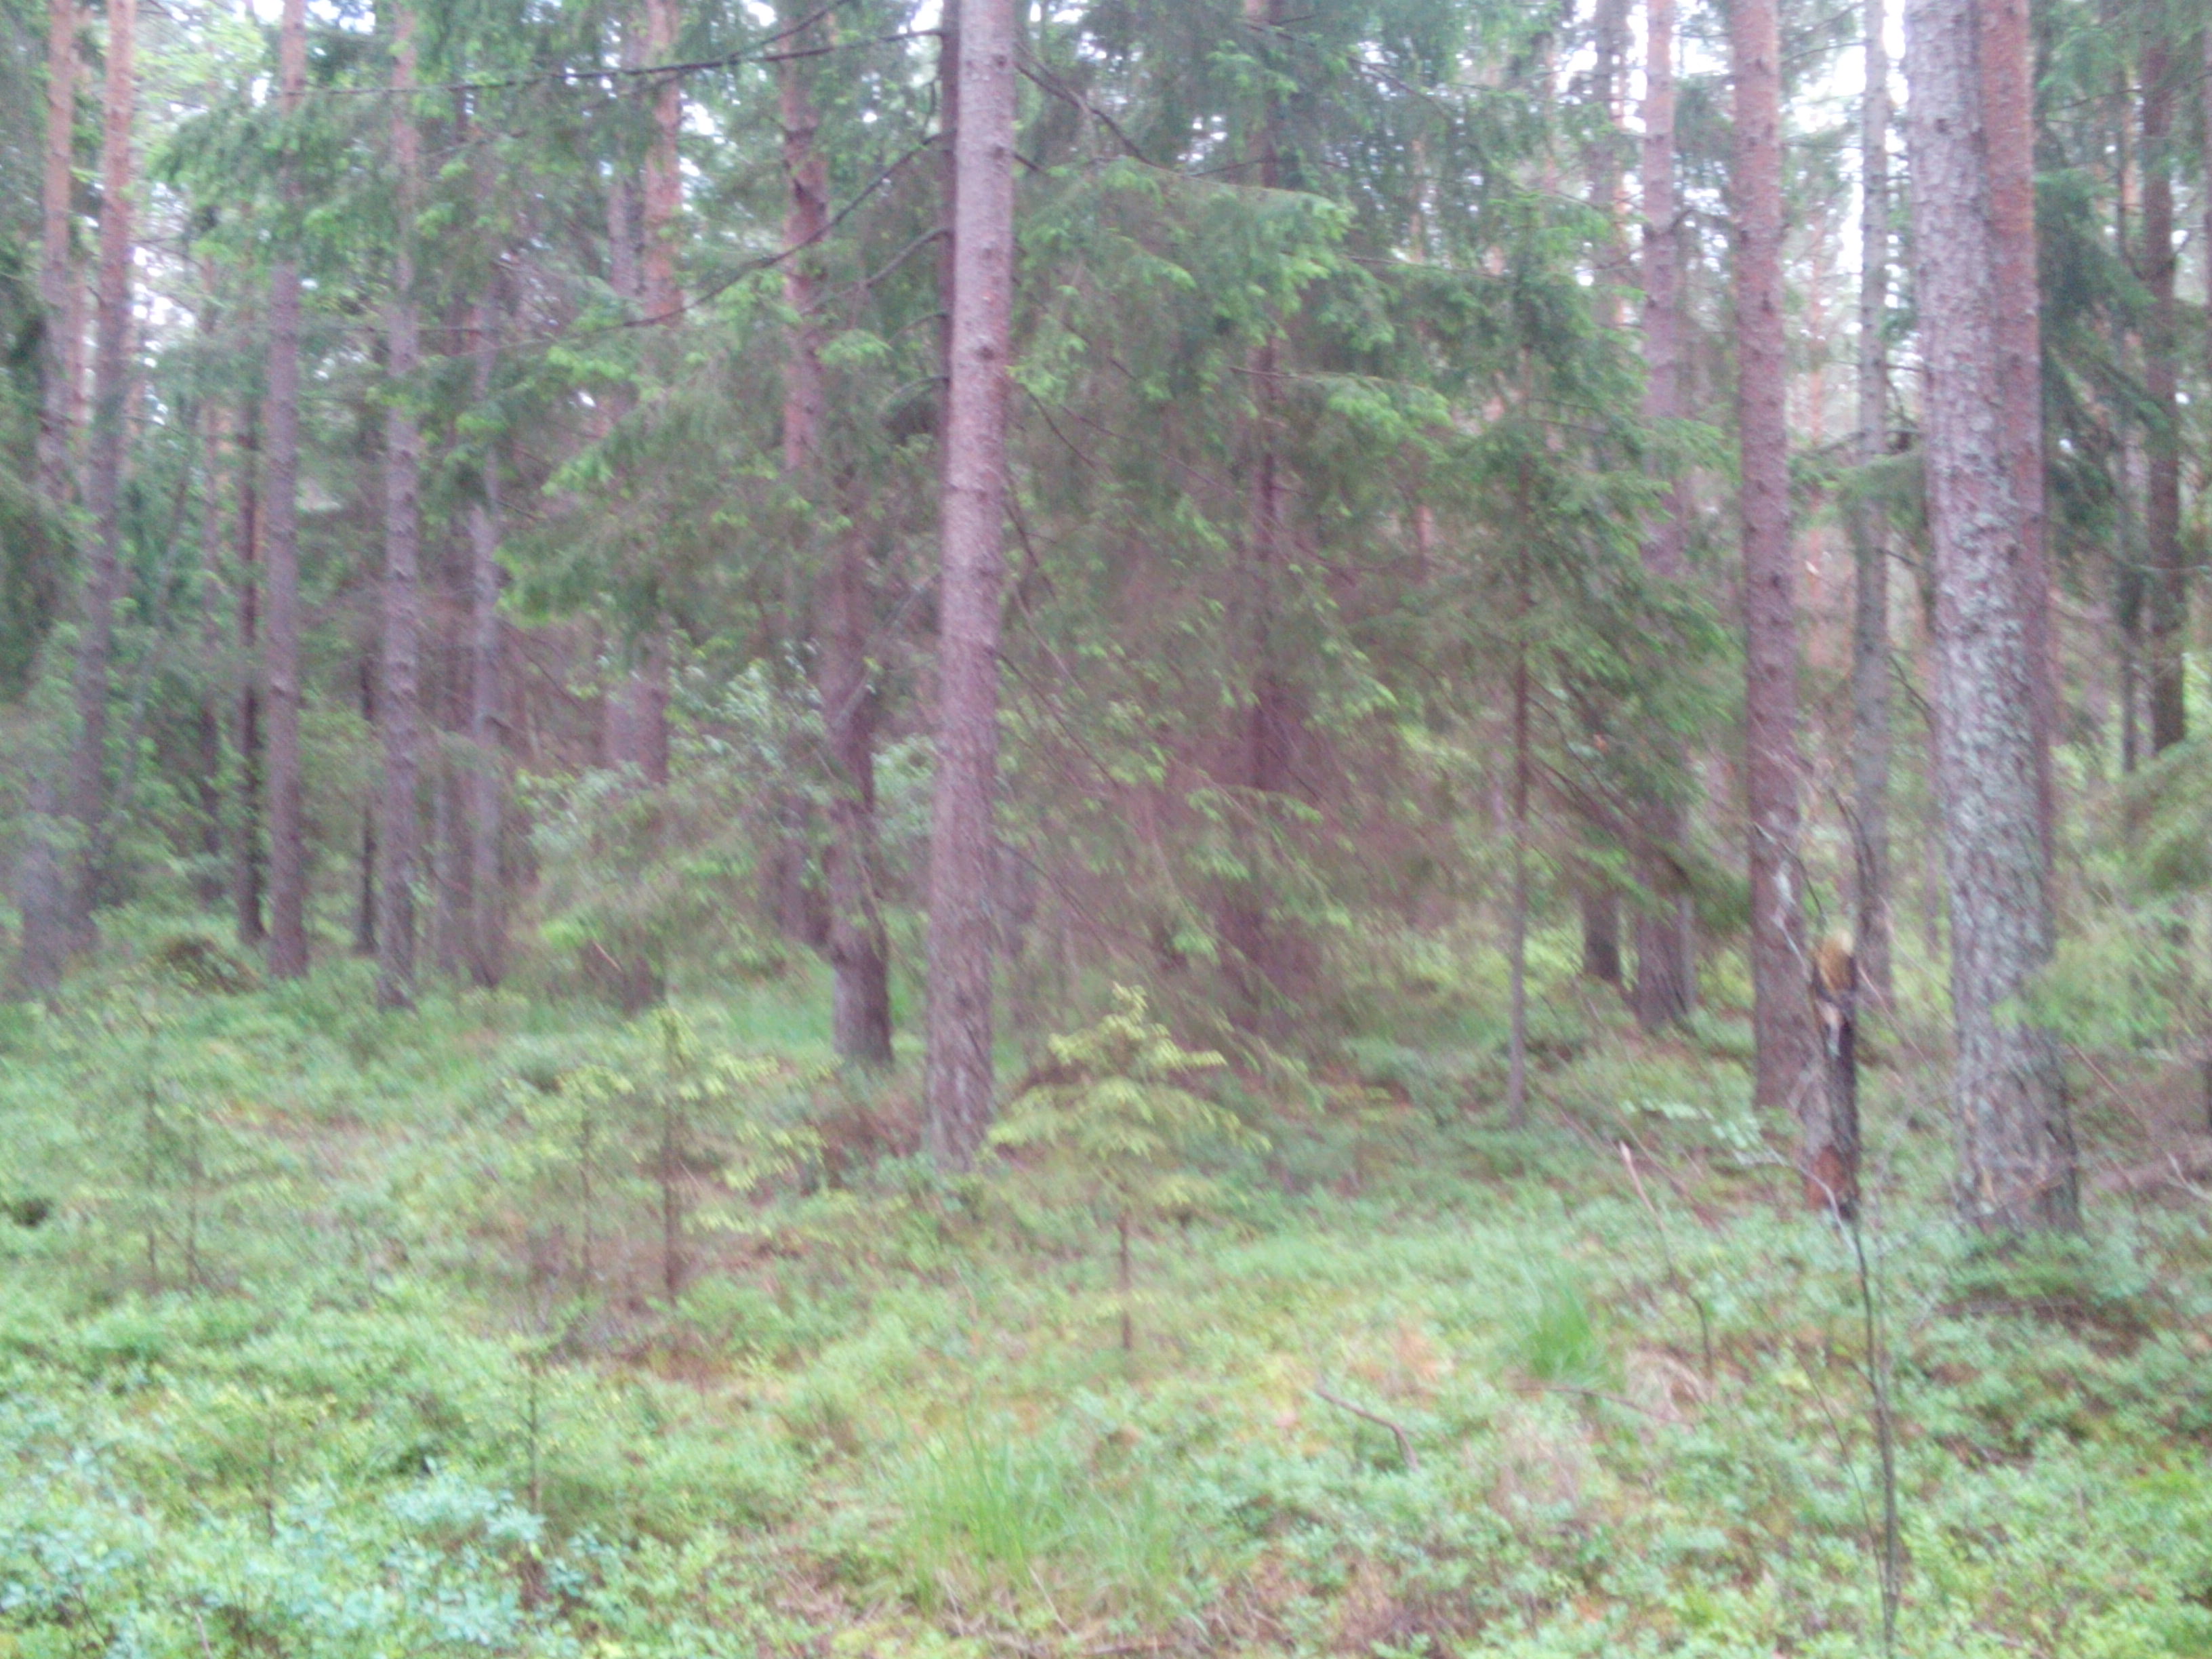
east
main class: Woodland
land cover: Other coniferous woodland
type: hemiboreal forest and nemoral coniferous forest and mixed broadleaved-coniferous forest
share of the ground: > 75 %
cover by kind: coniferous forest trees 80 %, herbaceous plants 10 %, lichens and mosses 10 %
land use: Forestry
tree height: > 5 m
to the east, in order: Other coniferous woodland; Other mixed woodland
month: June
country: LV
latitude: 56.9420
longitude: 21.4971
